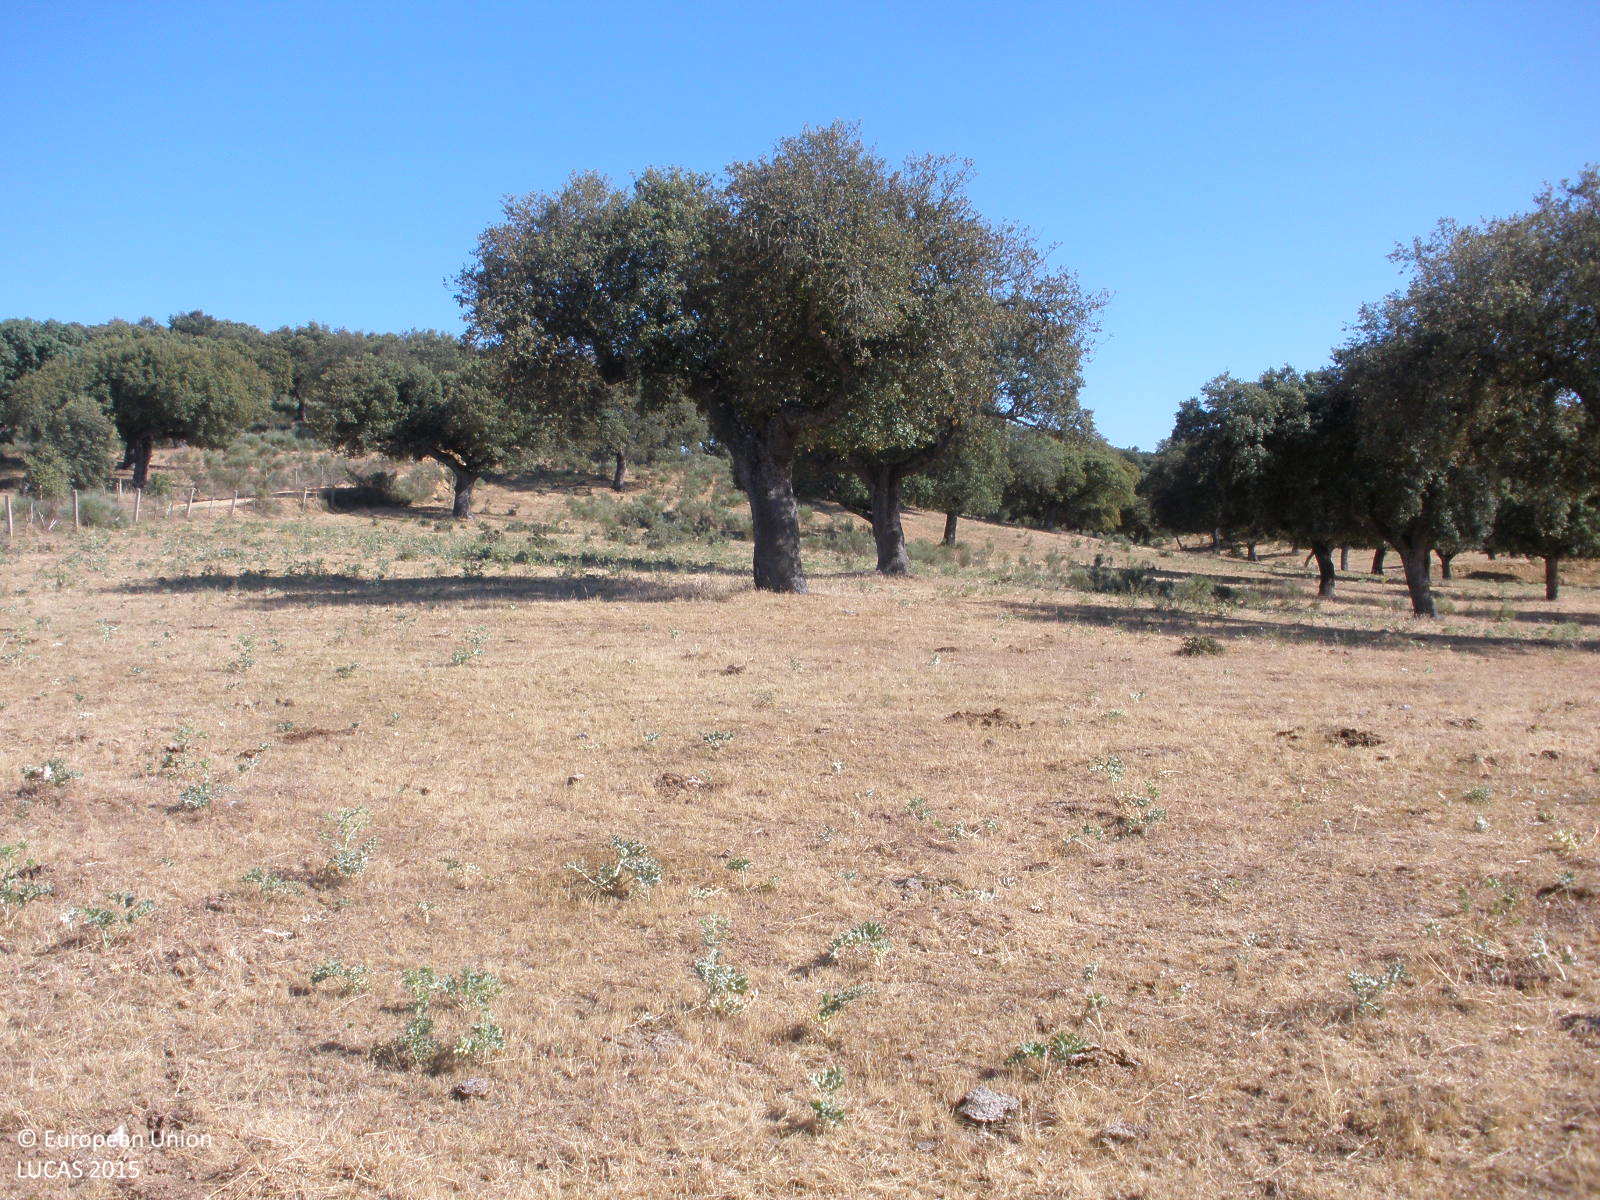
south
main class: Grassland
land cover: Grassland with sparse tree/shrub cover
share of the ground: > 75 %
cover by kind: herbaceous plants 95 %, broadleaved forest trees 5 %
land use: Agriculture (excluding fallow land and kitchen gardens)
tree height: > 5 m
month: June
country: ES
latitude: 40.5276
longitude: -6.6532
